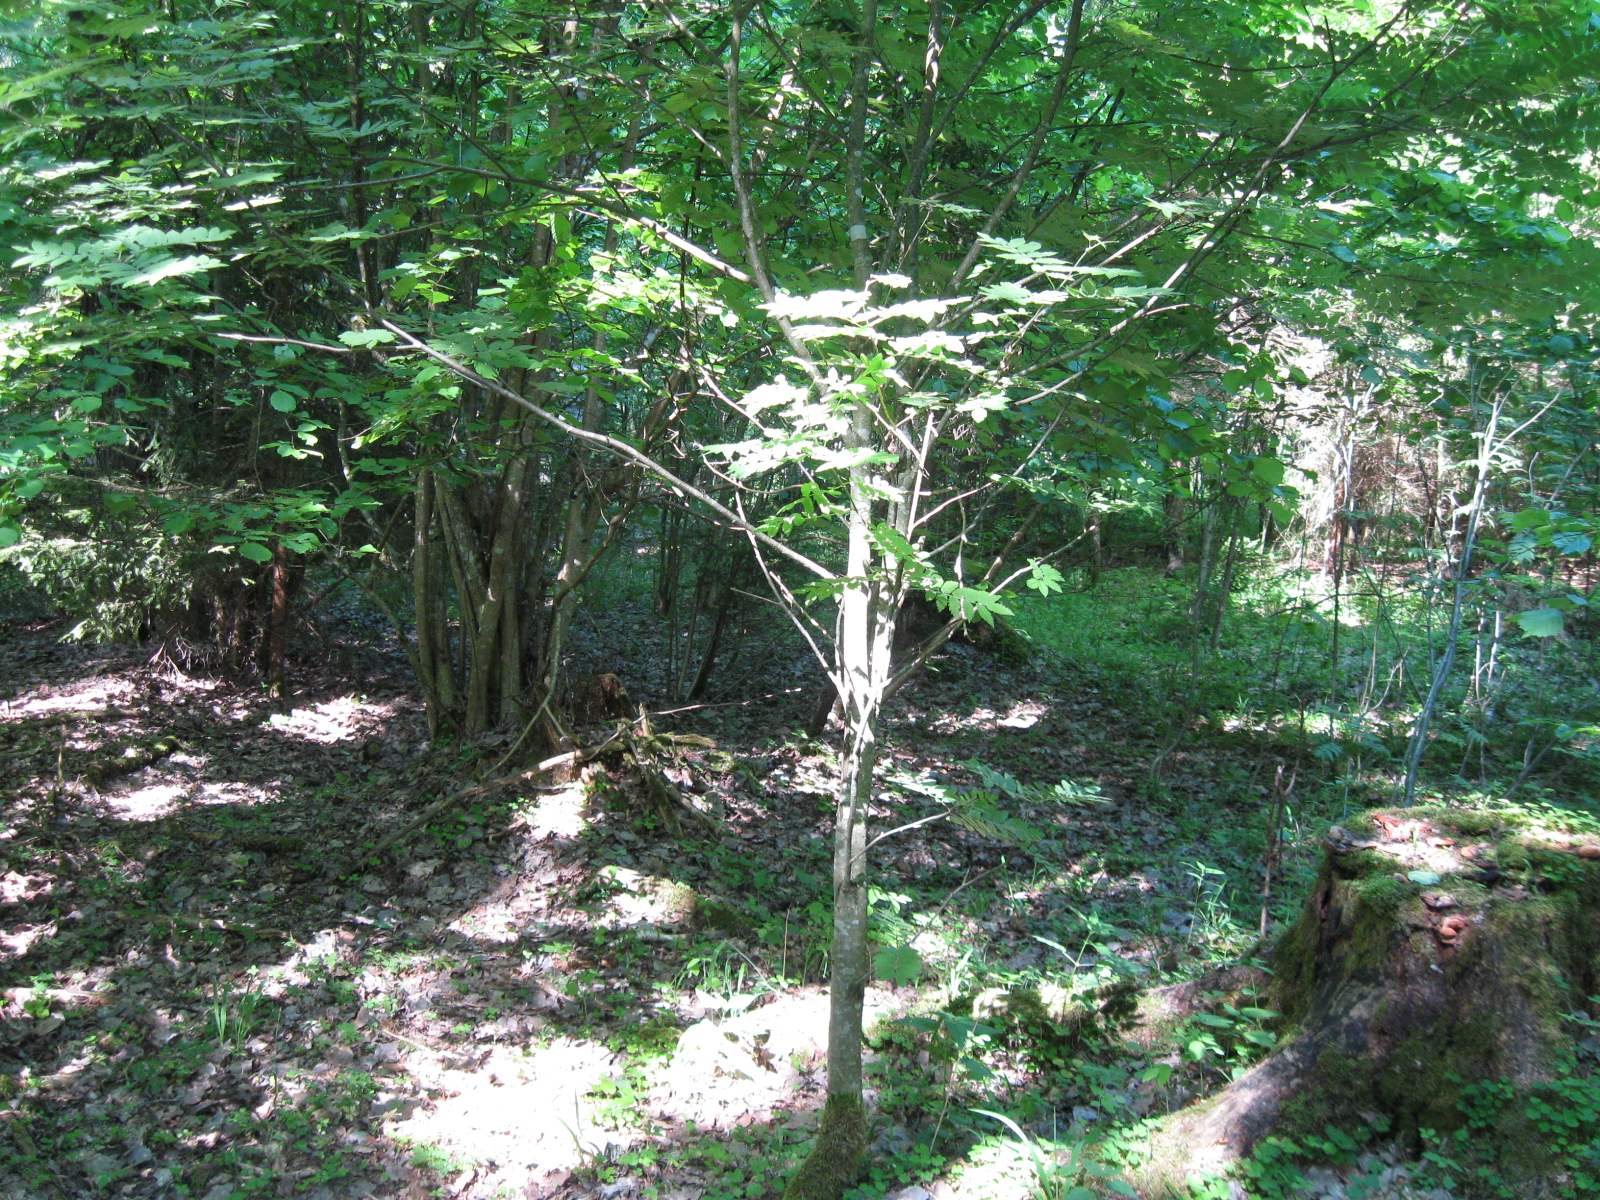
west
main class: Woodland
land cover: Spruce dominated mixed woodland
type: hemiboreal forest and nemoral coniferous forest and mixed broadleaved-coniferous forest
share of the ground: > 75 %
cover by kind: broadleaved forest trees 55 %, coniferous forest trees 40 %, herbaceous plants 5 %
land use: Forestry
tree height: > 5 m
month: June
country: LT
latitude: 54.5565
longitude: 23.8349
